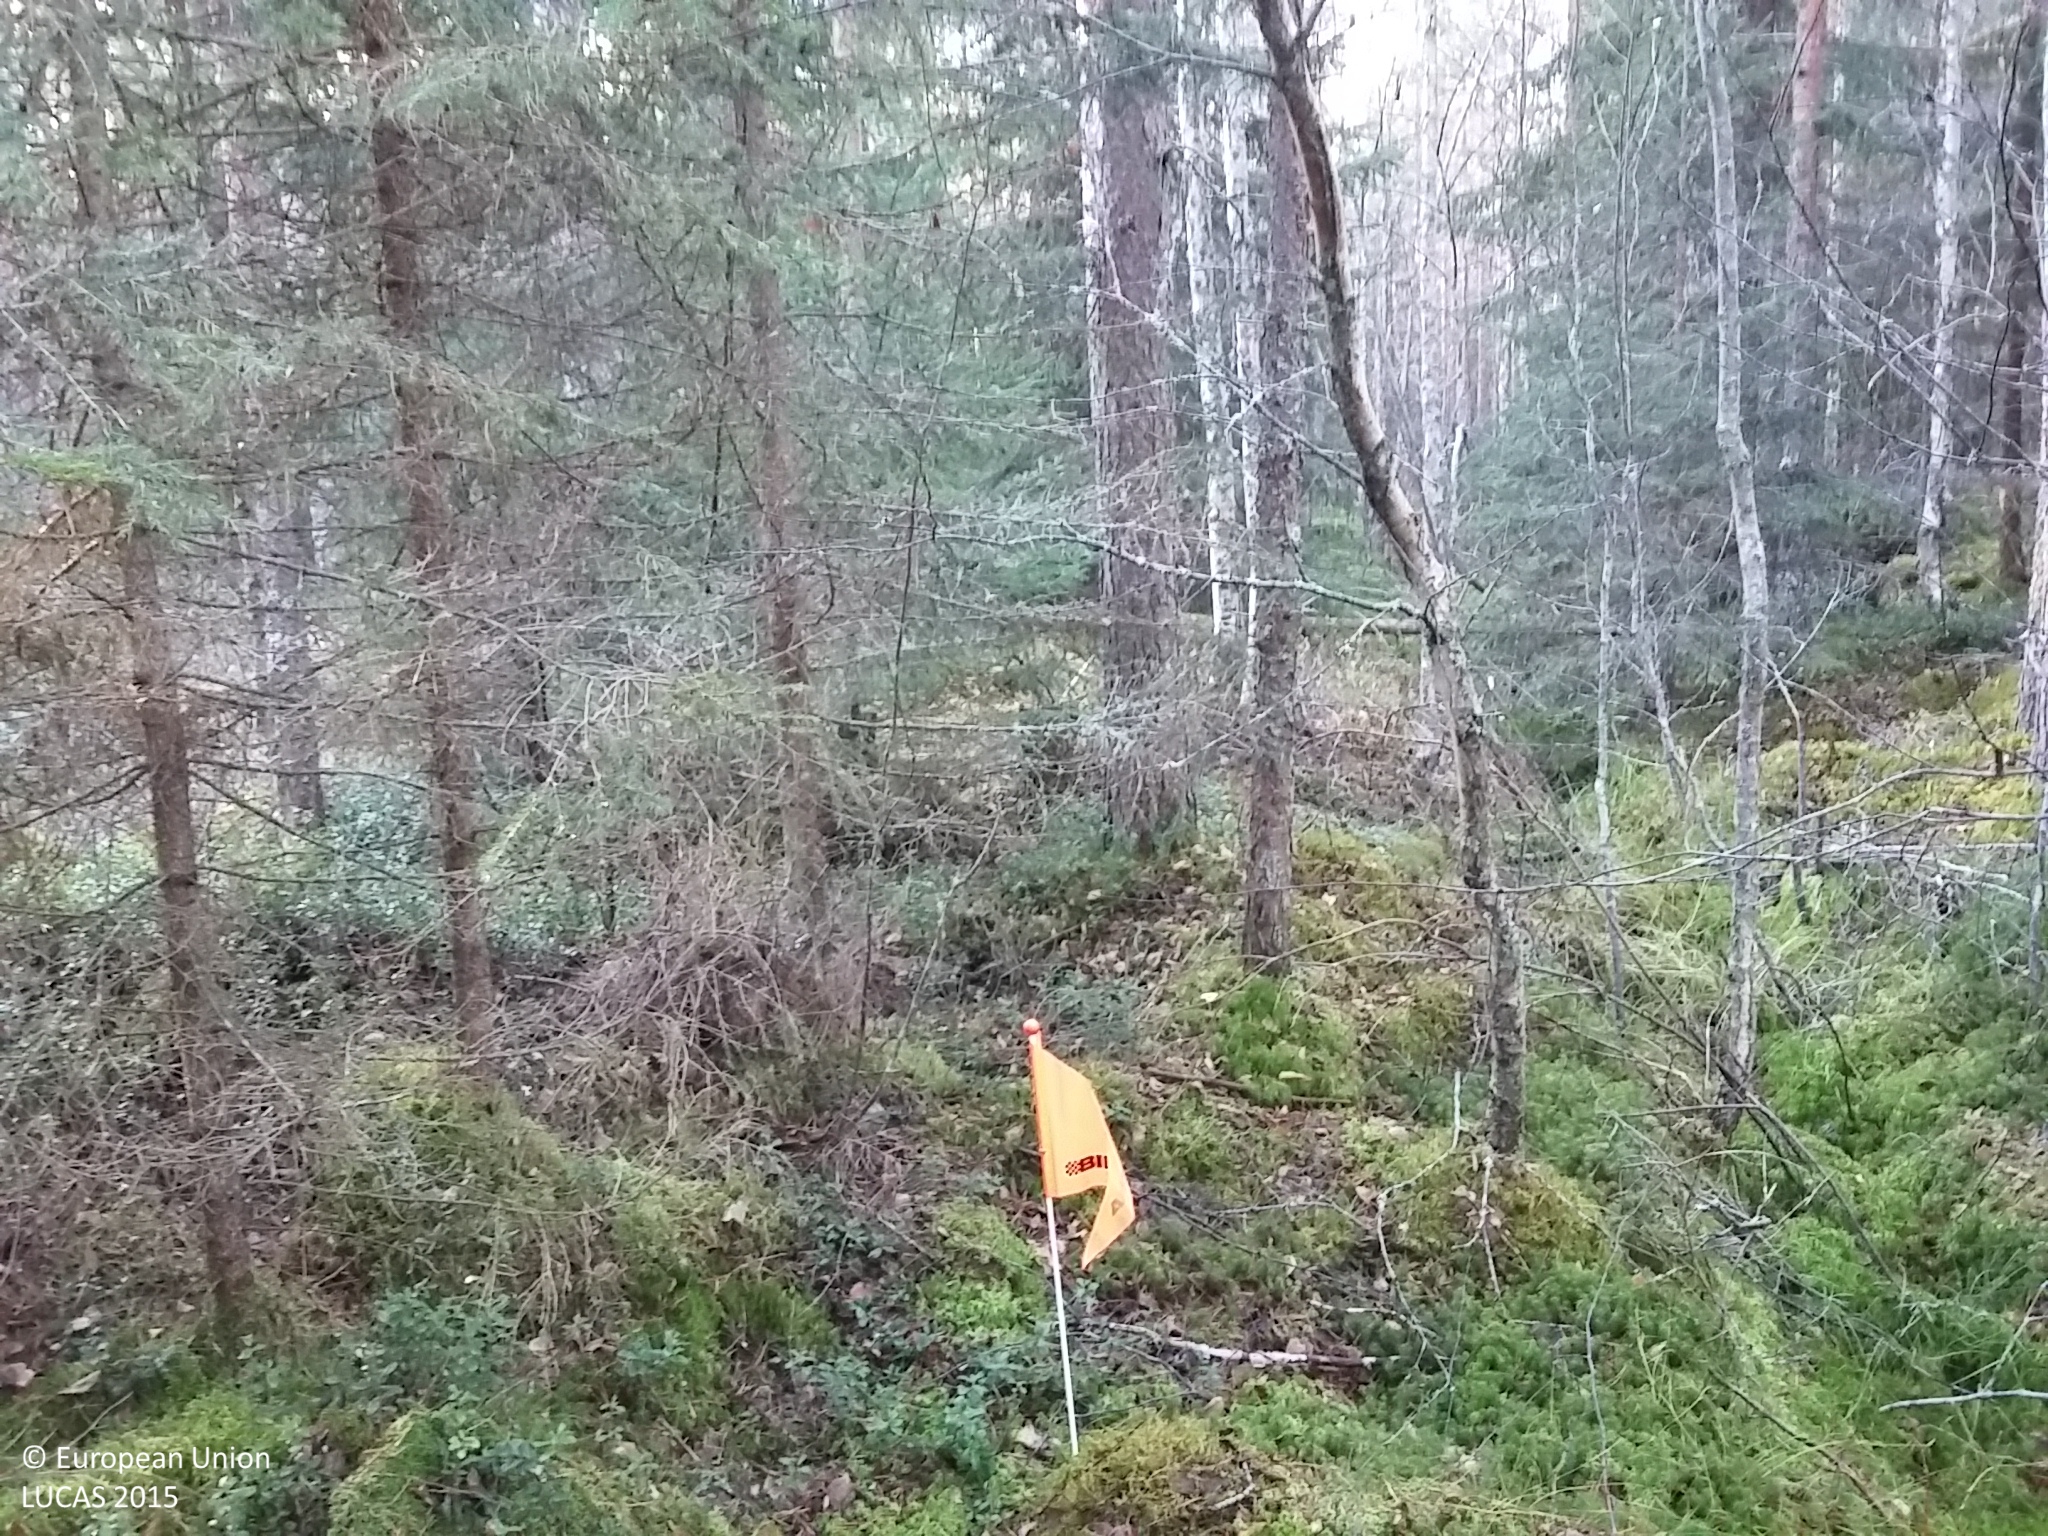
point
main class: Woodland
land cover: Other coniferous woodland
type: boreal forest
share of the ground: > 75 %
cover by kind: coniferous forest trees 80 %, broadleaved forest trees 10 %, herbaceous plants 5 %, lichens and mosses 5 %
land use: Forestry
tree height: > 5 m
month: October
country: FI
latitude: 64.5928
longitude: 25.4839
